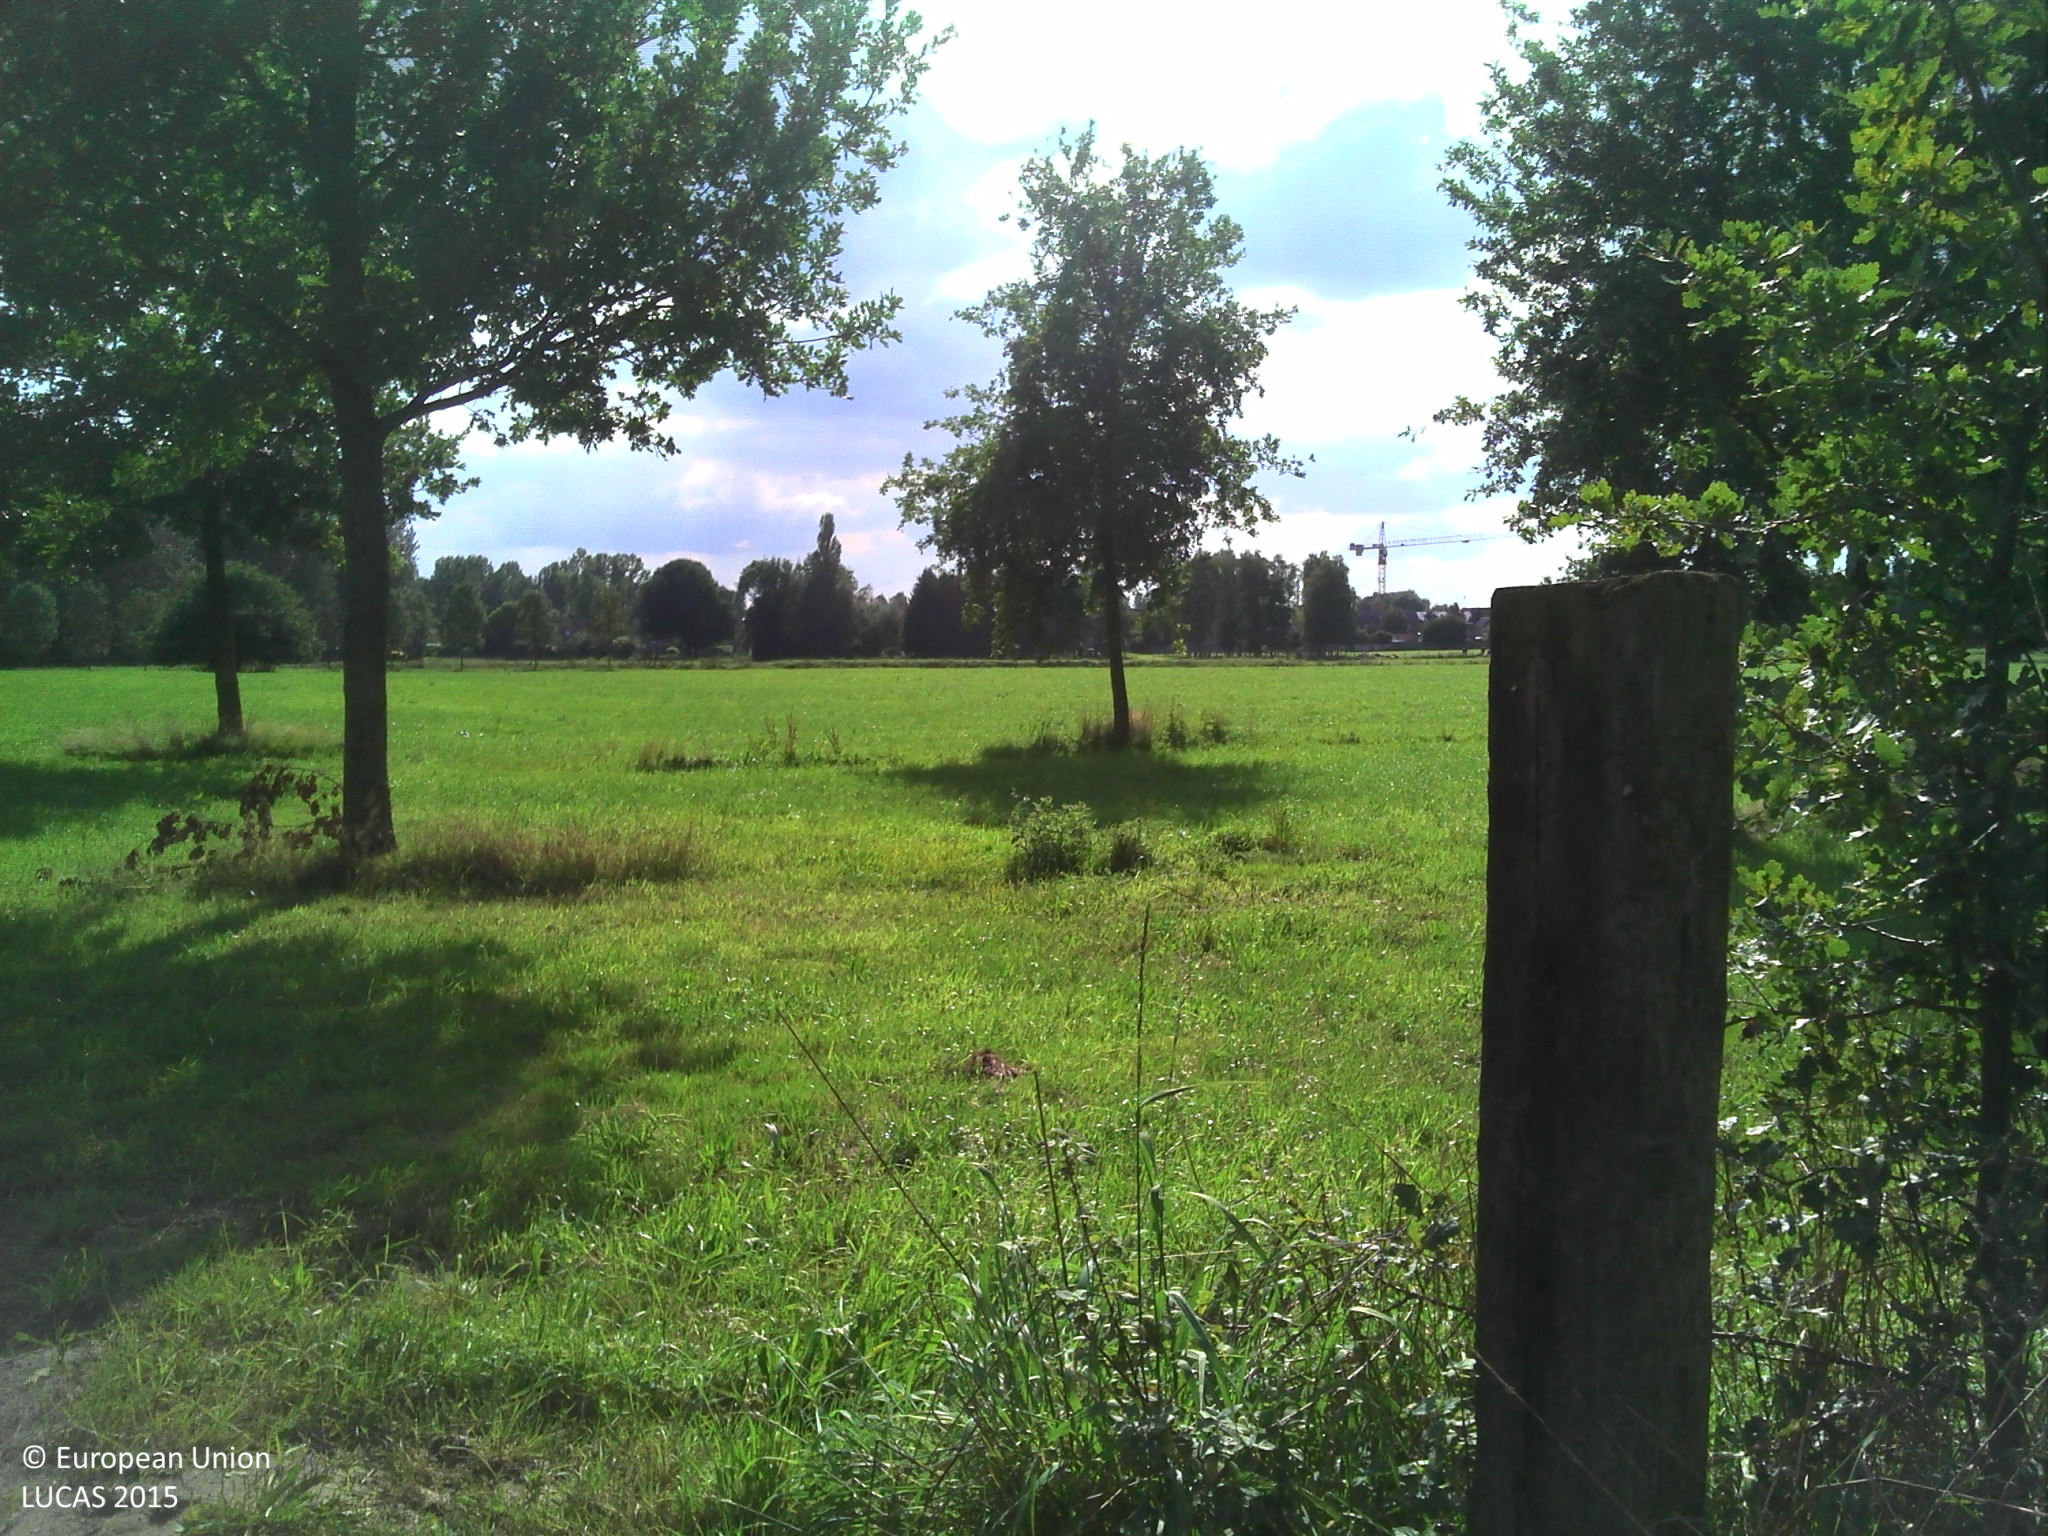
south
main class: Grassland
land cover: Grassland without tree/shrub cover
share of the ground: > 75 %
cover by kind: herbaceous plants 100 %
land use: Agriculture (excluding fallow land and kitchen gardens)
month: September
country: BE
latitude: 51.1227
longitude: 4.6670
